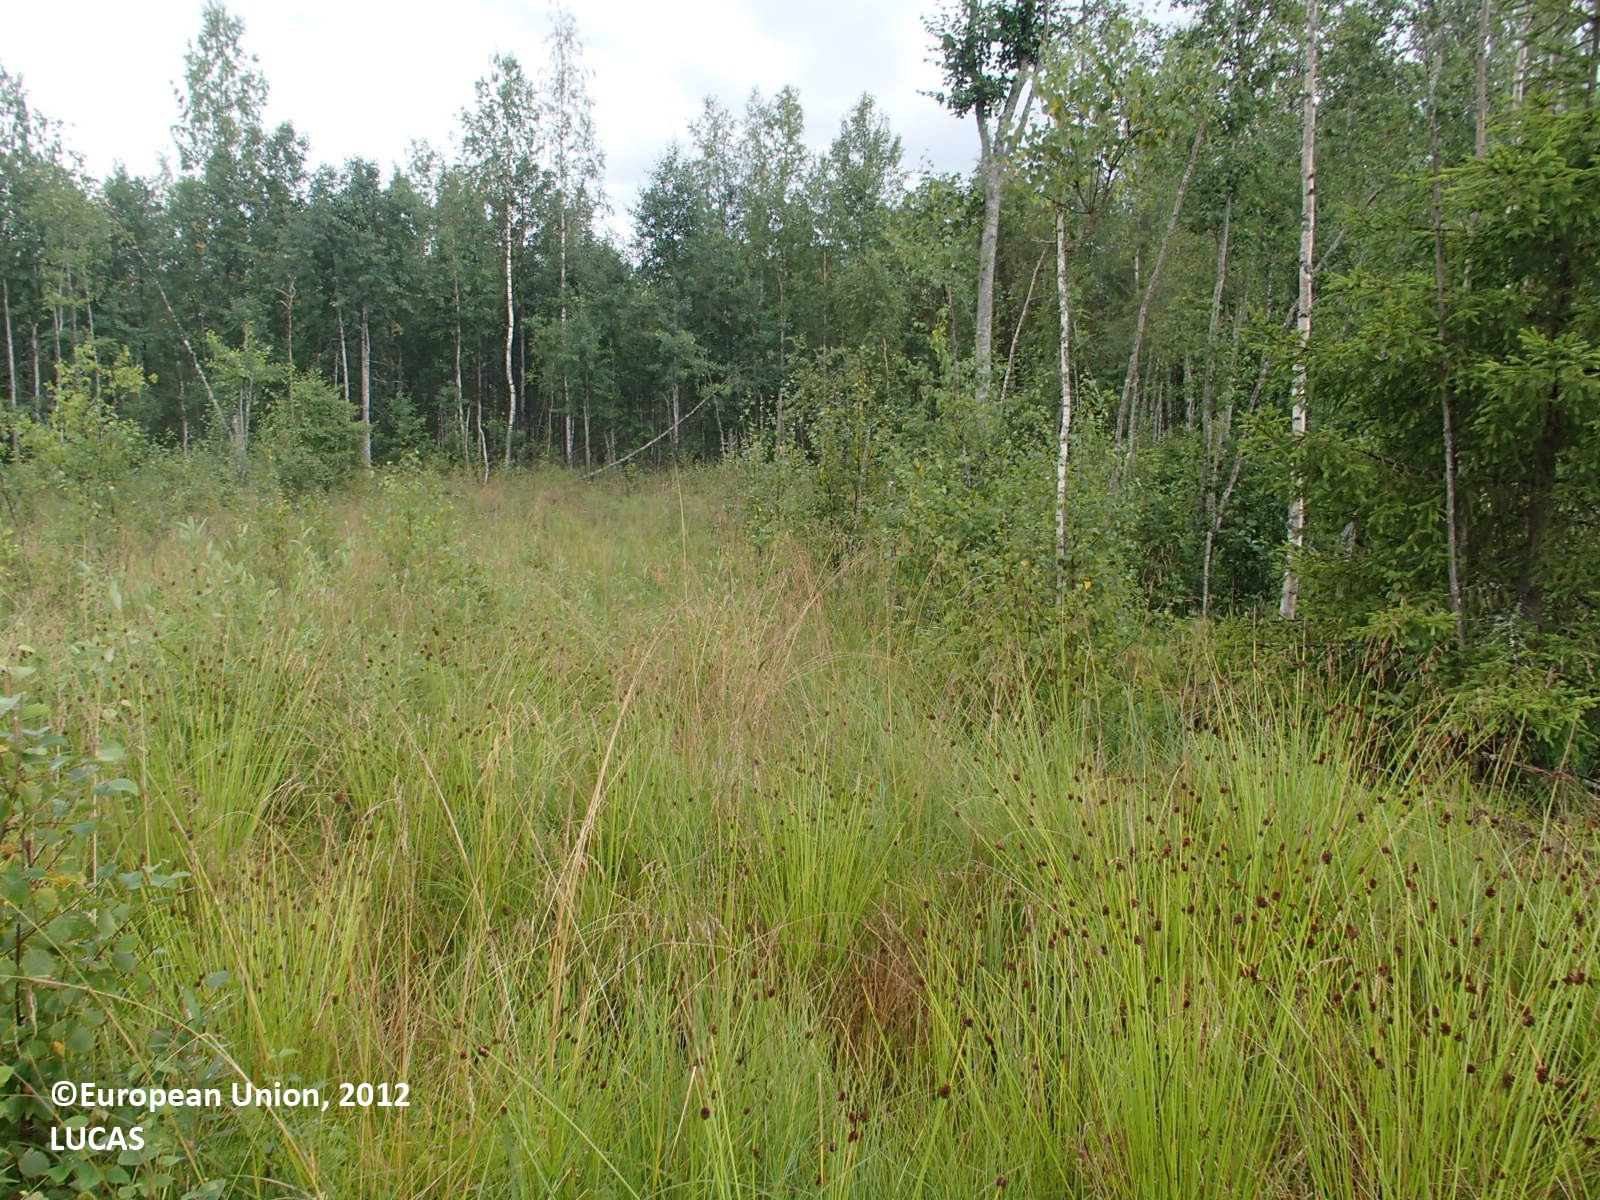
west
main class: Woodland
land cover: Spruce dominated mixed woodland
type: boreal forest
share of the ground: > 75 %
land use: Forestry
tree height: < 5 m
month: August
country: FI
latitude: 64.1144
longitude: 26.1859
